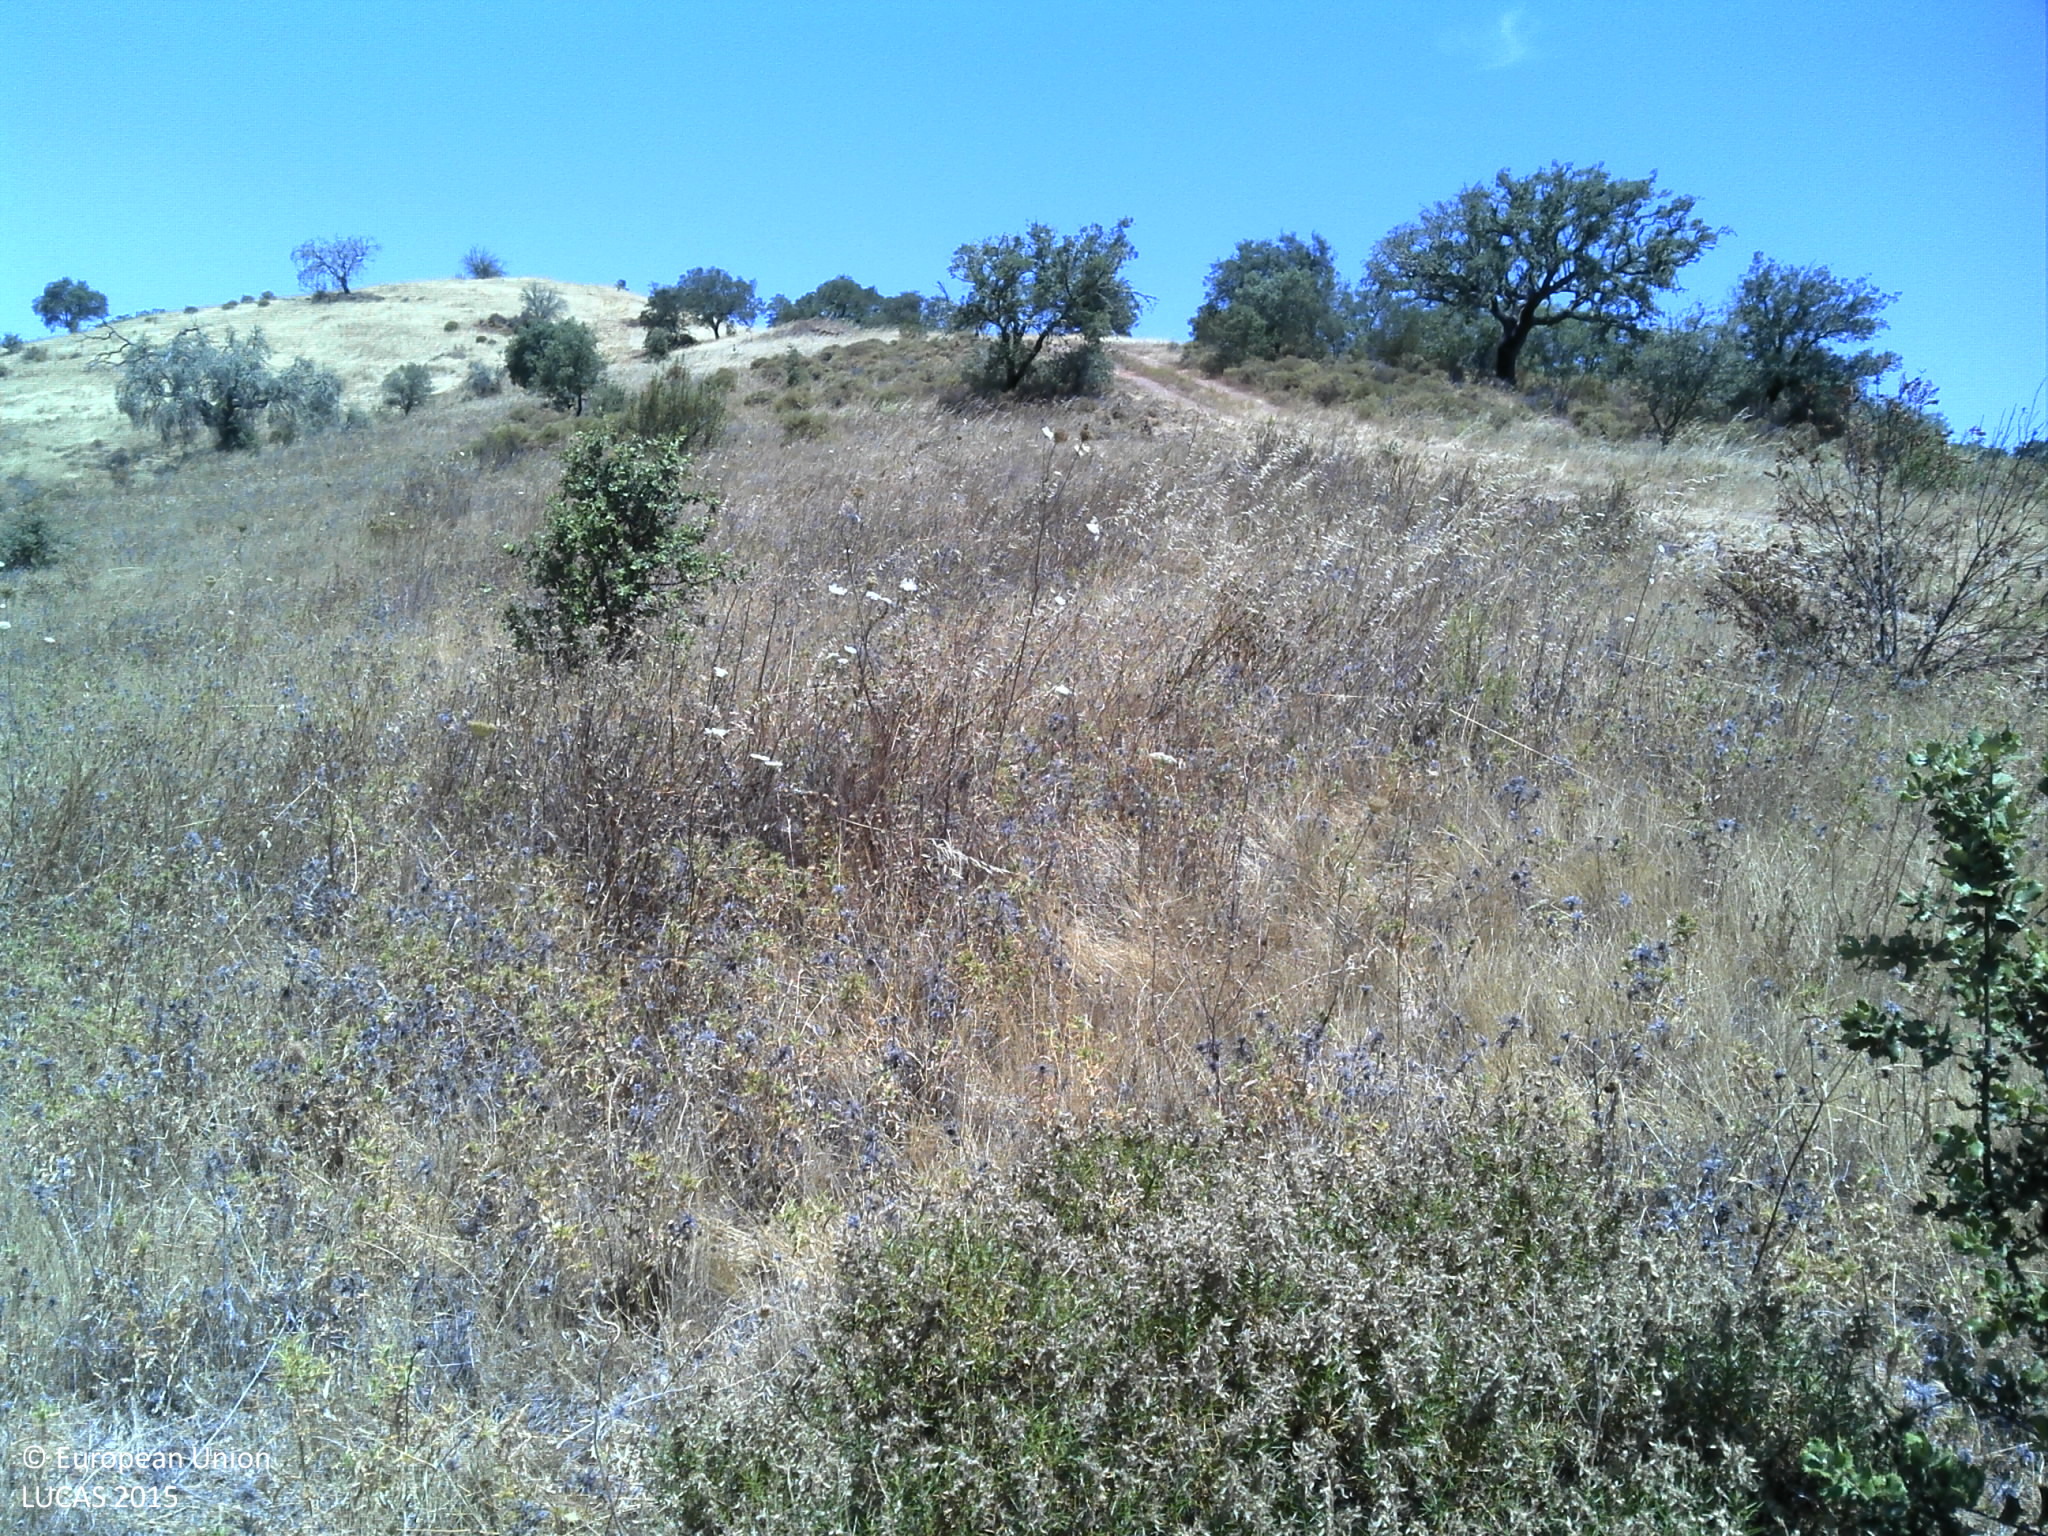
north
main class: Shrubland
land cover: Shrubland with sparse tree cover
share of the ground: 25 - 50 %
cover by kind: shrubs 50 %, herbaceous plants 30 %, unconsolidated bare surface 15 %, broadleaved forest trees 5 %
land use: Agriculture (excluding fallow land and kitchen gardens)
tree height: > 5 m
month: June
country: PT
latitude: 37.8699
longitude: -7.4888
